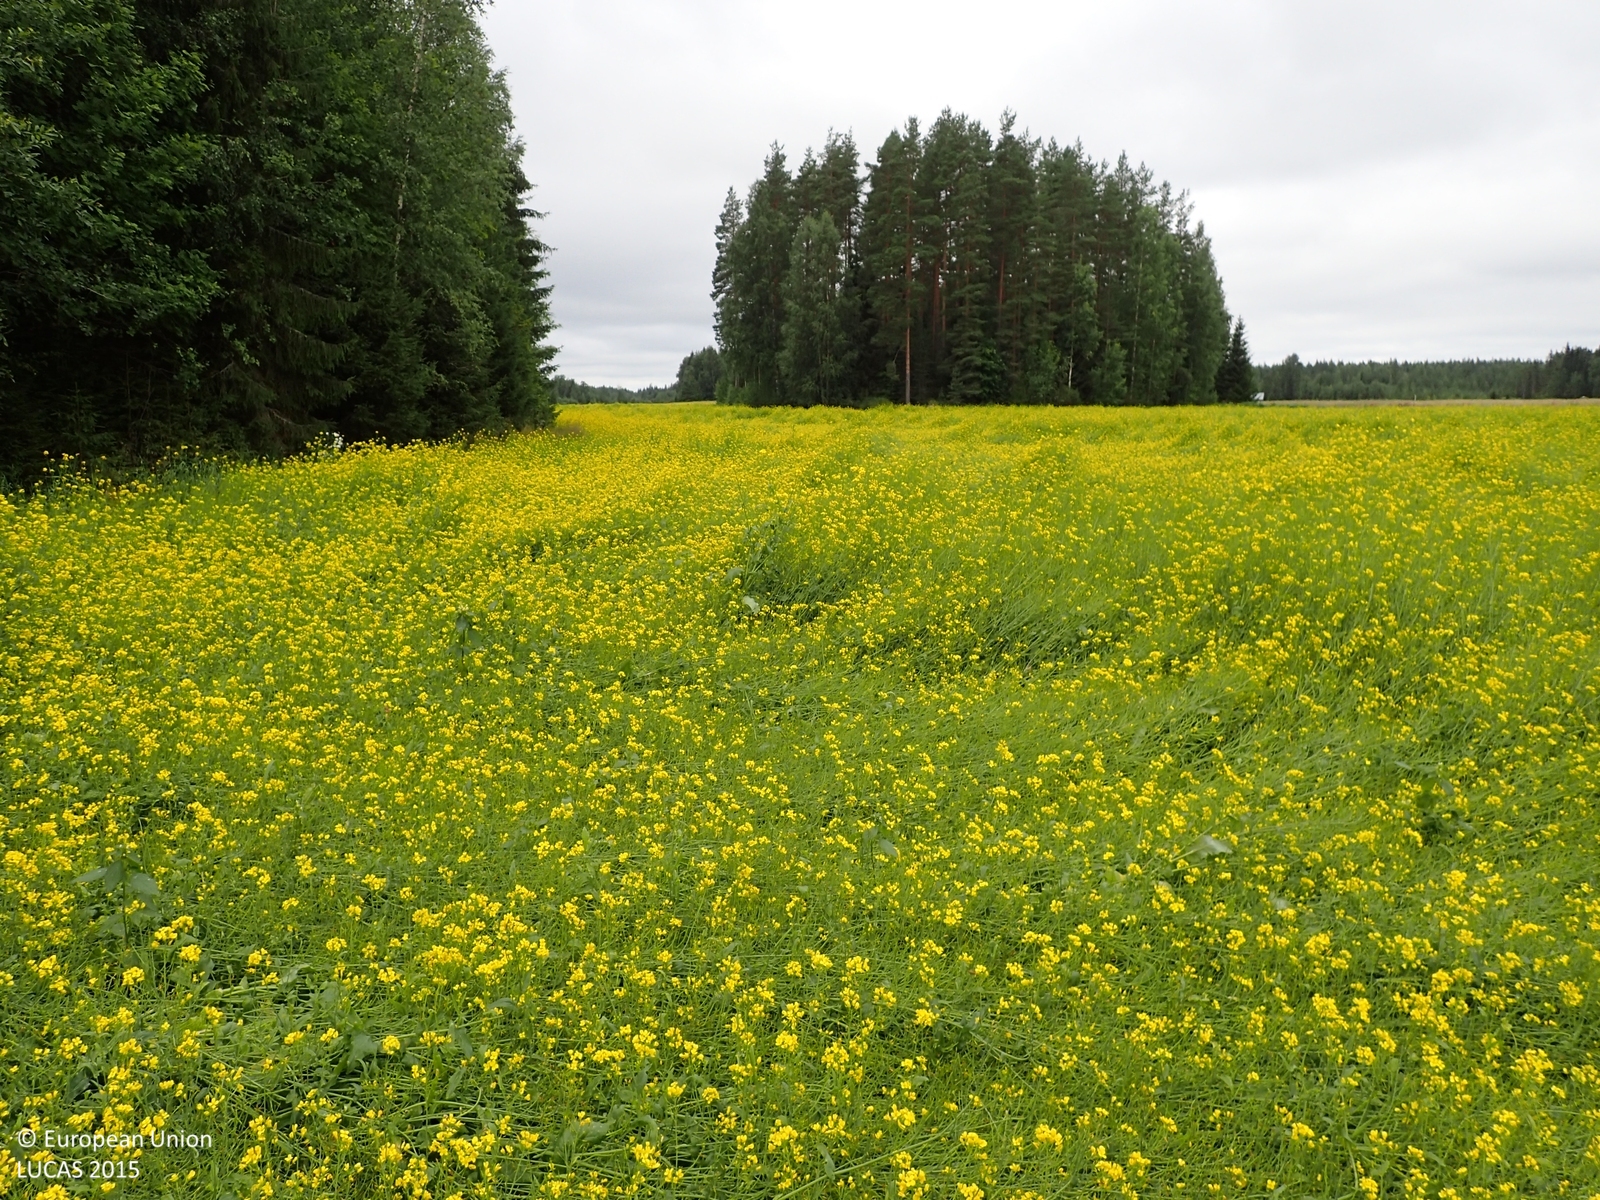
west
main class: Cropland
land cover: Rape and turnip rape
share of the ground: > 75 %
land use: Agriculture (excluding fallow land and kitchen gardens)
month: August
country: FI
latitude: 62.8815
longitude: 21.9820
